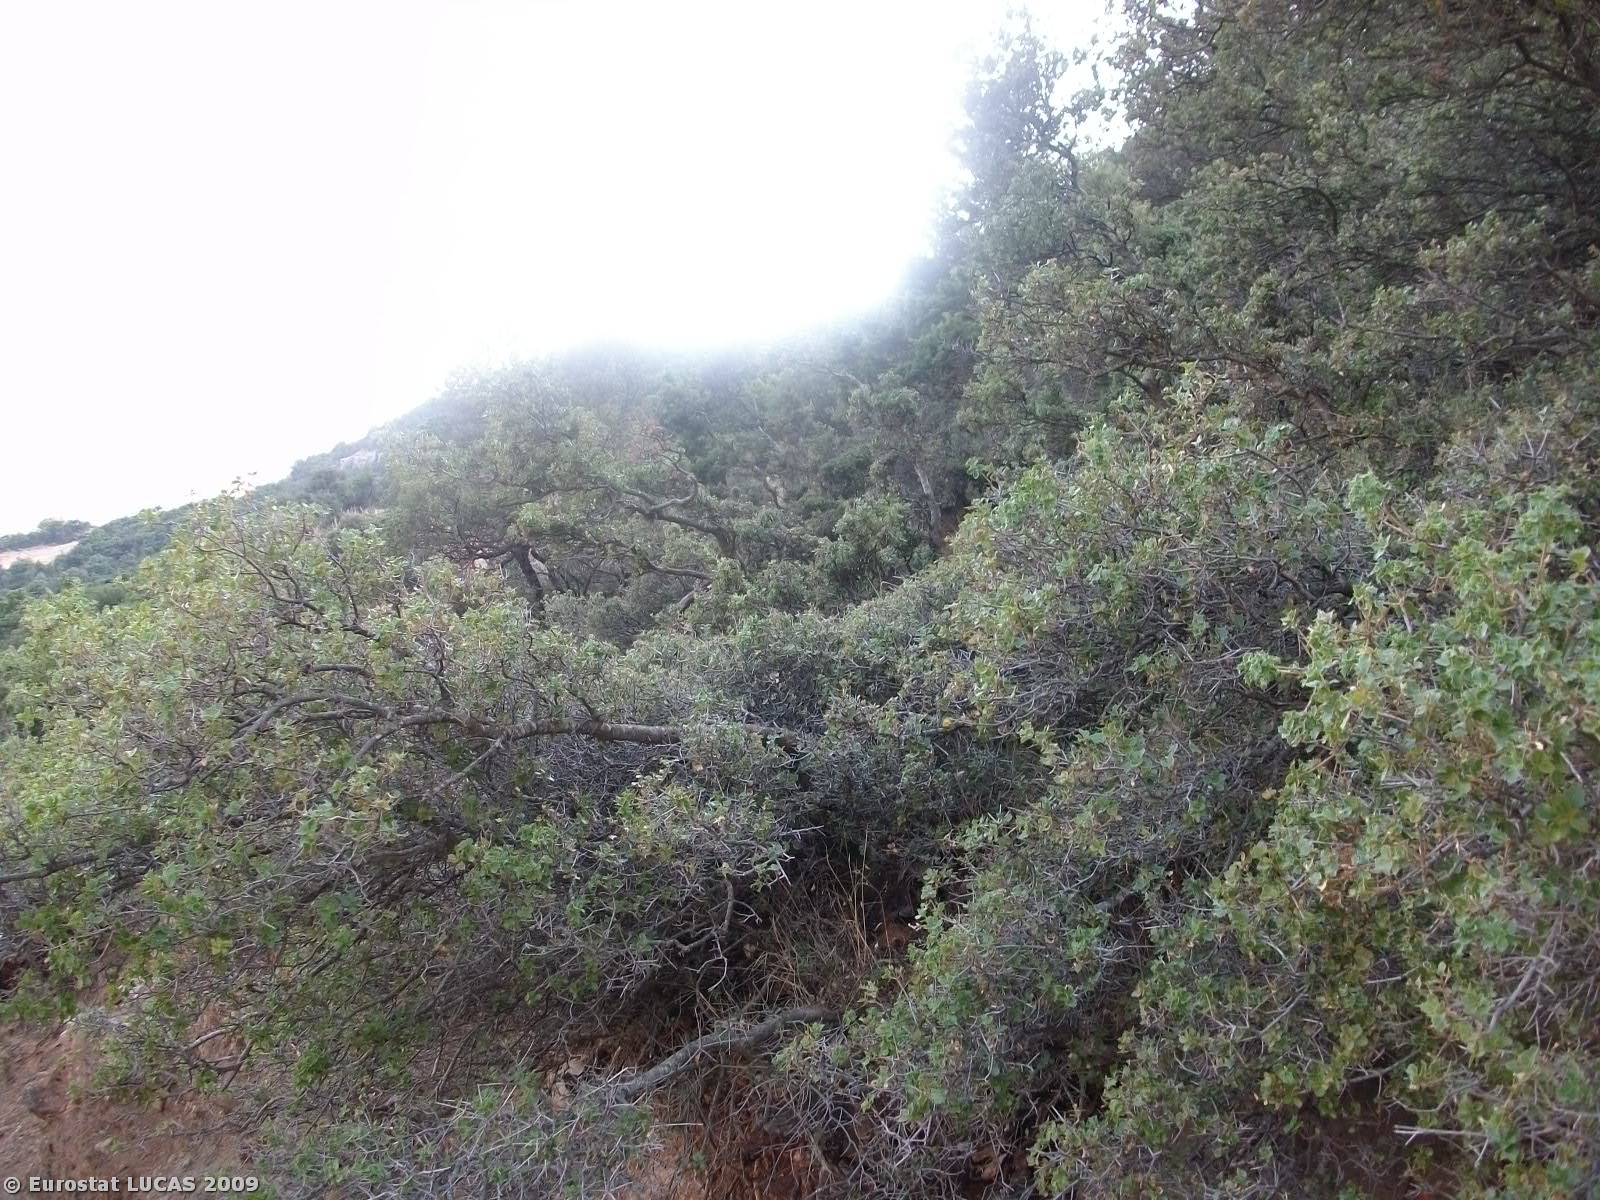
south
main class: Bare land
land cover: Bare land
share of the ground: 50 - 75 %
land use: Road transport
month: August
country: GR
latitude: 37.7431
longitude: 22.5060
